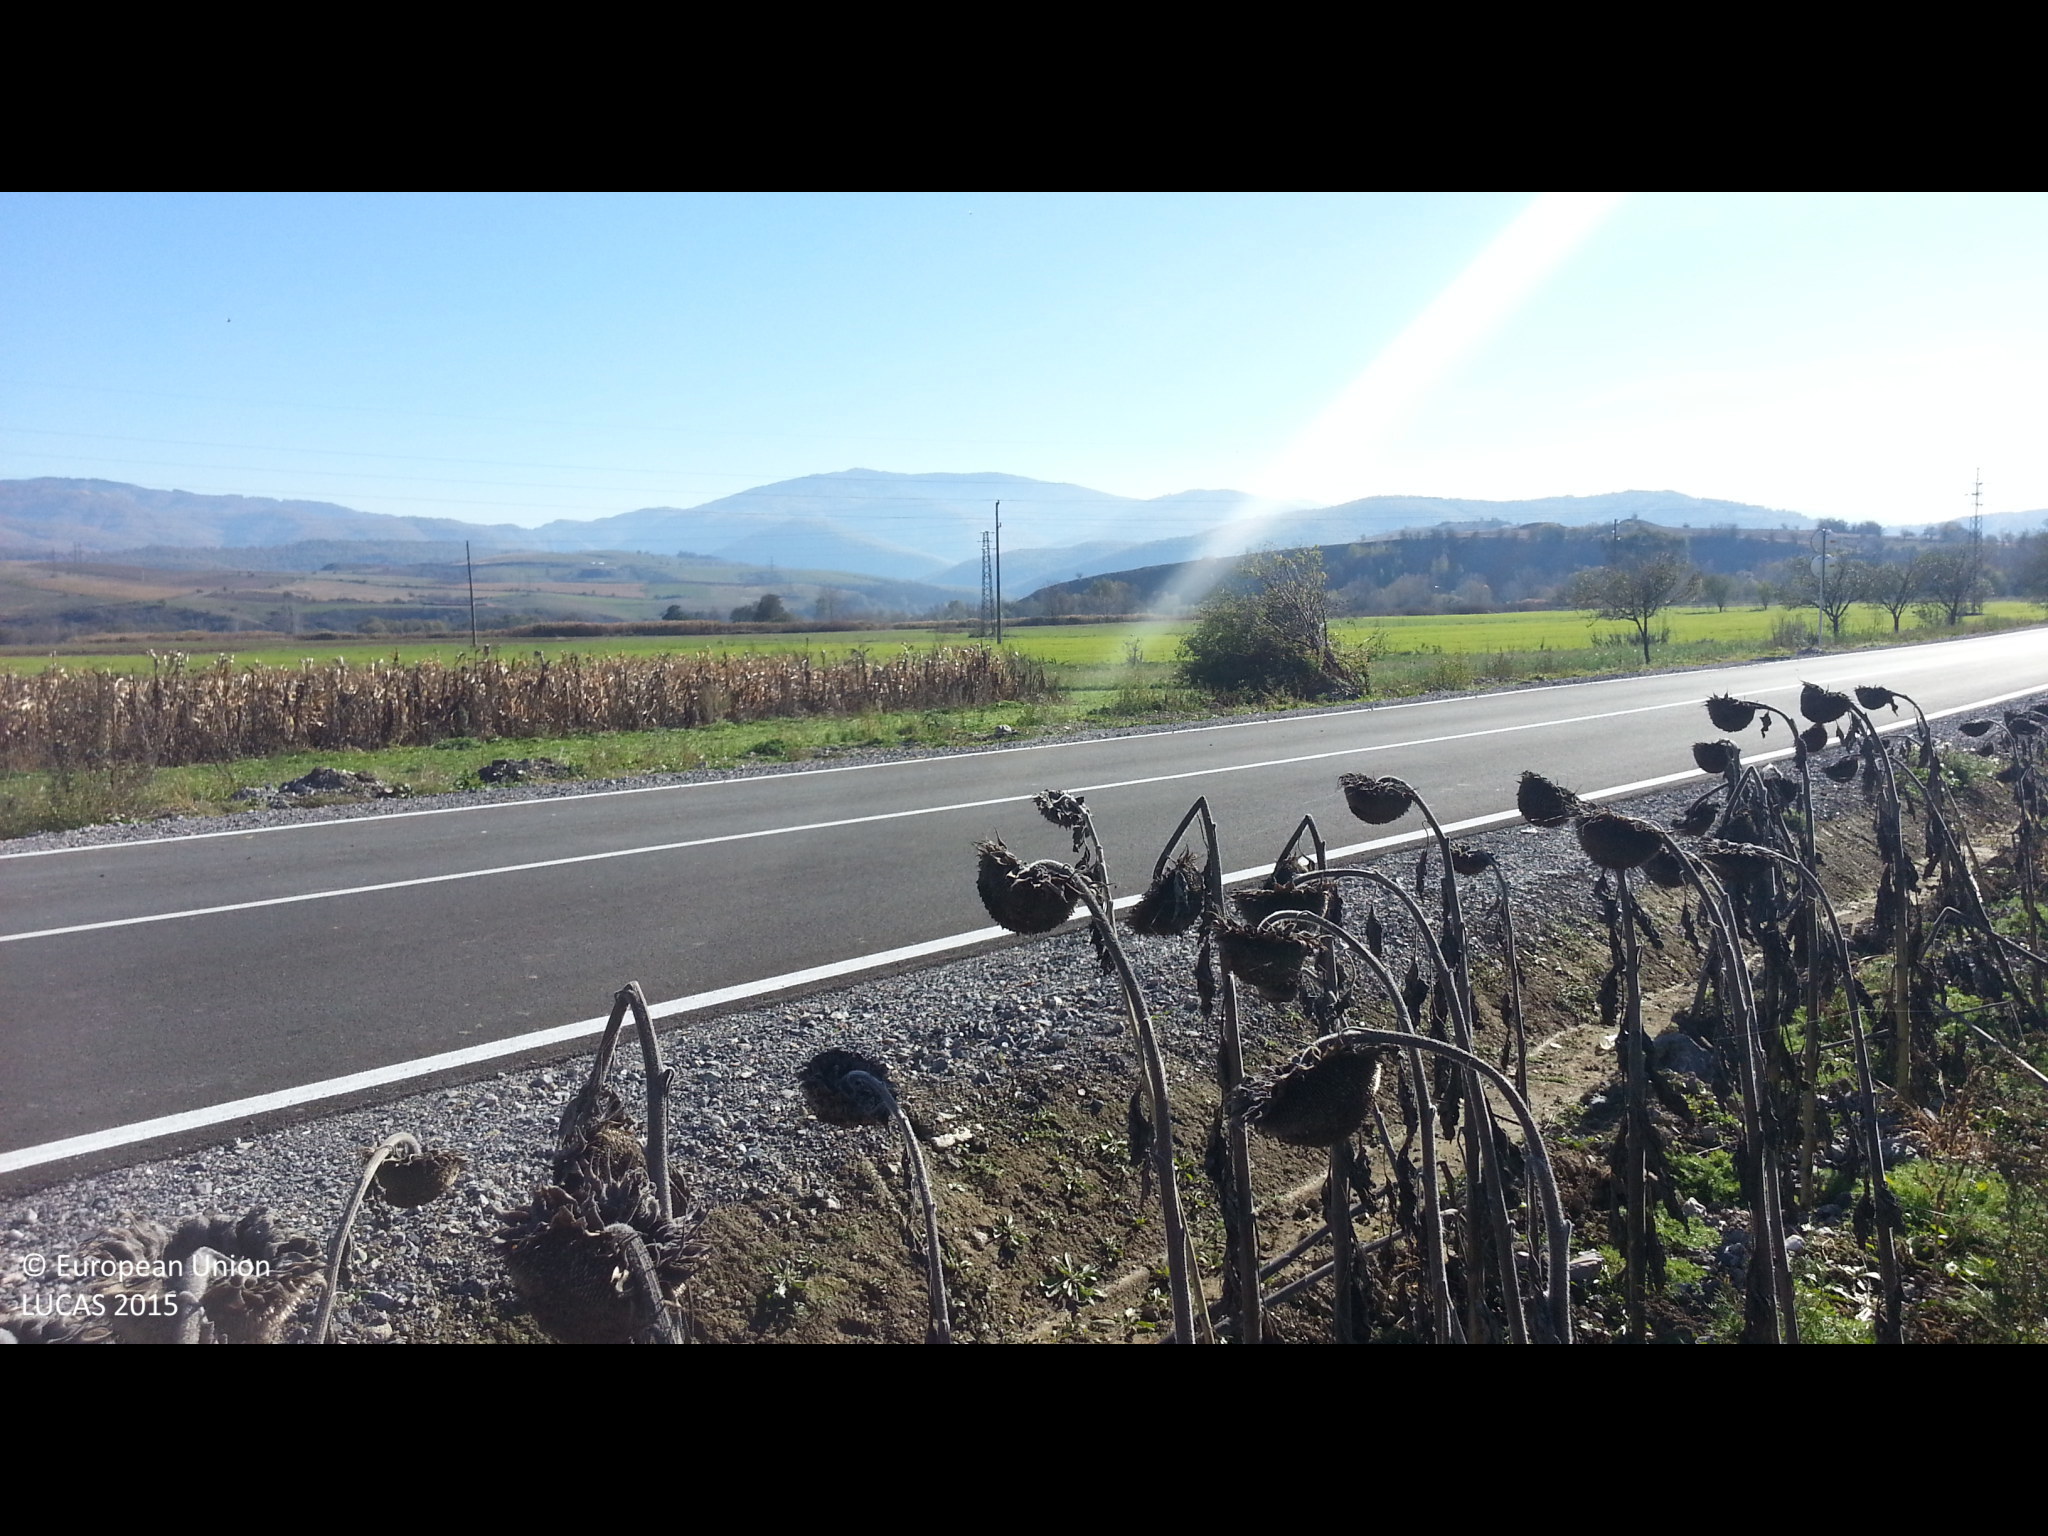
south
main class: Cropland
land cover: Sunflower
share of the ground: 50 - 75 %
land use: Agriculture (excluding fallow land and kitchen gardens)
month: November
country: BG
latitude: 42.7022
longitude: 24.1225
